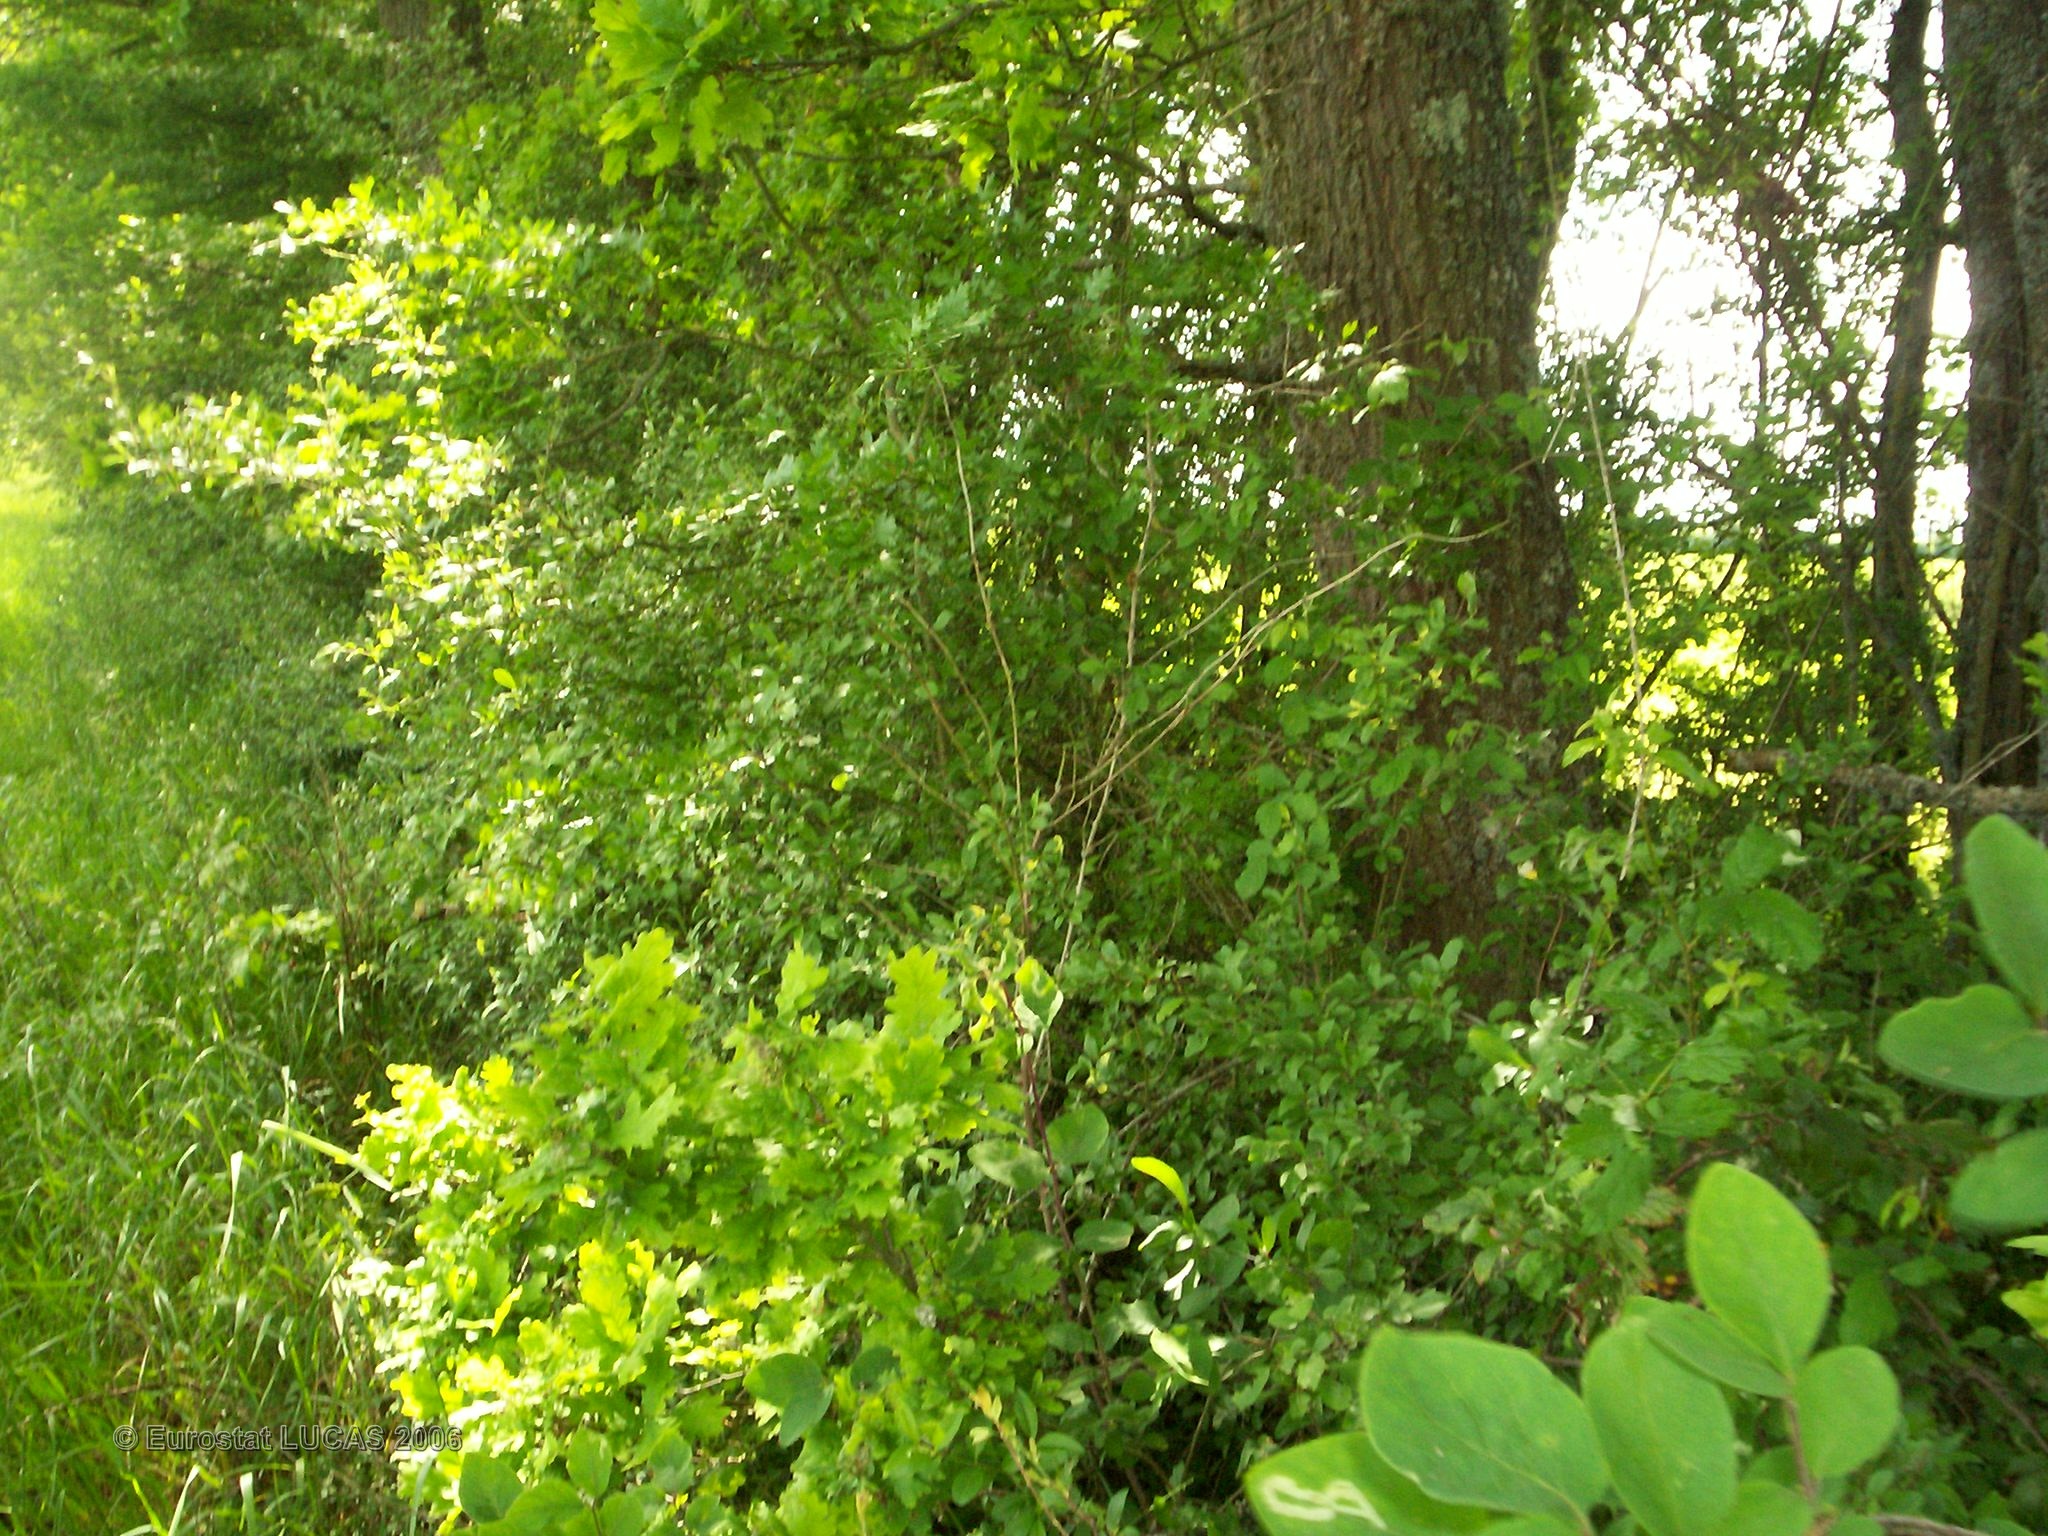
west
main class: Grassland
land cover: Grassland without tree/shrub cover
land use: Agriculture (excluding fallow land and kitchen gardens)
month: May
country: FR
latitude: 47.5371
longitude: 4.0064
